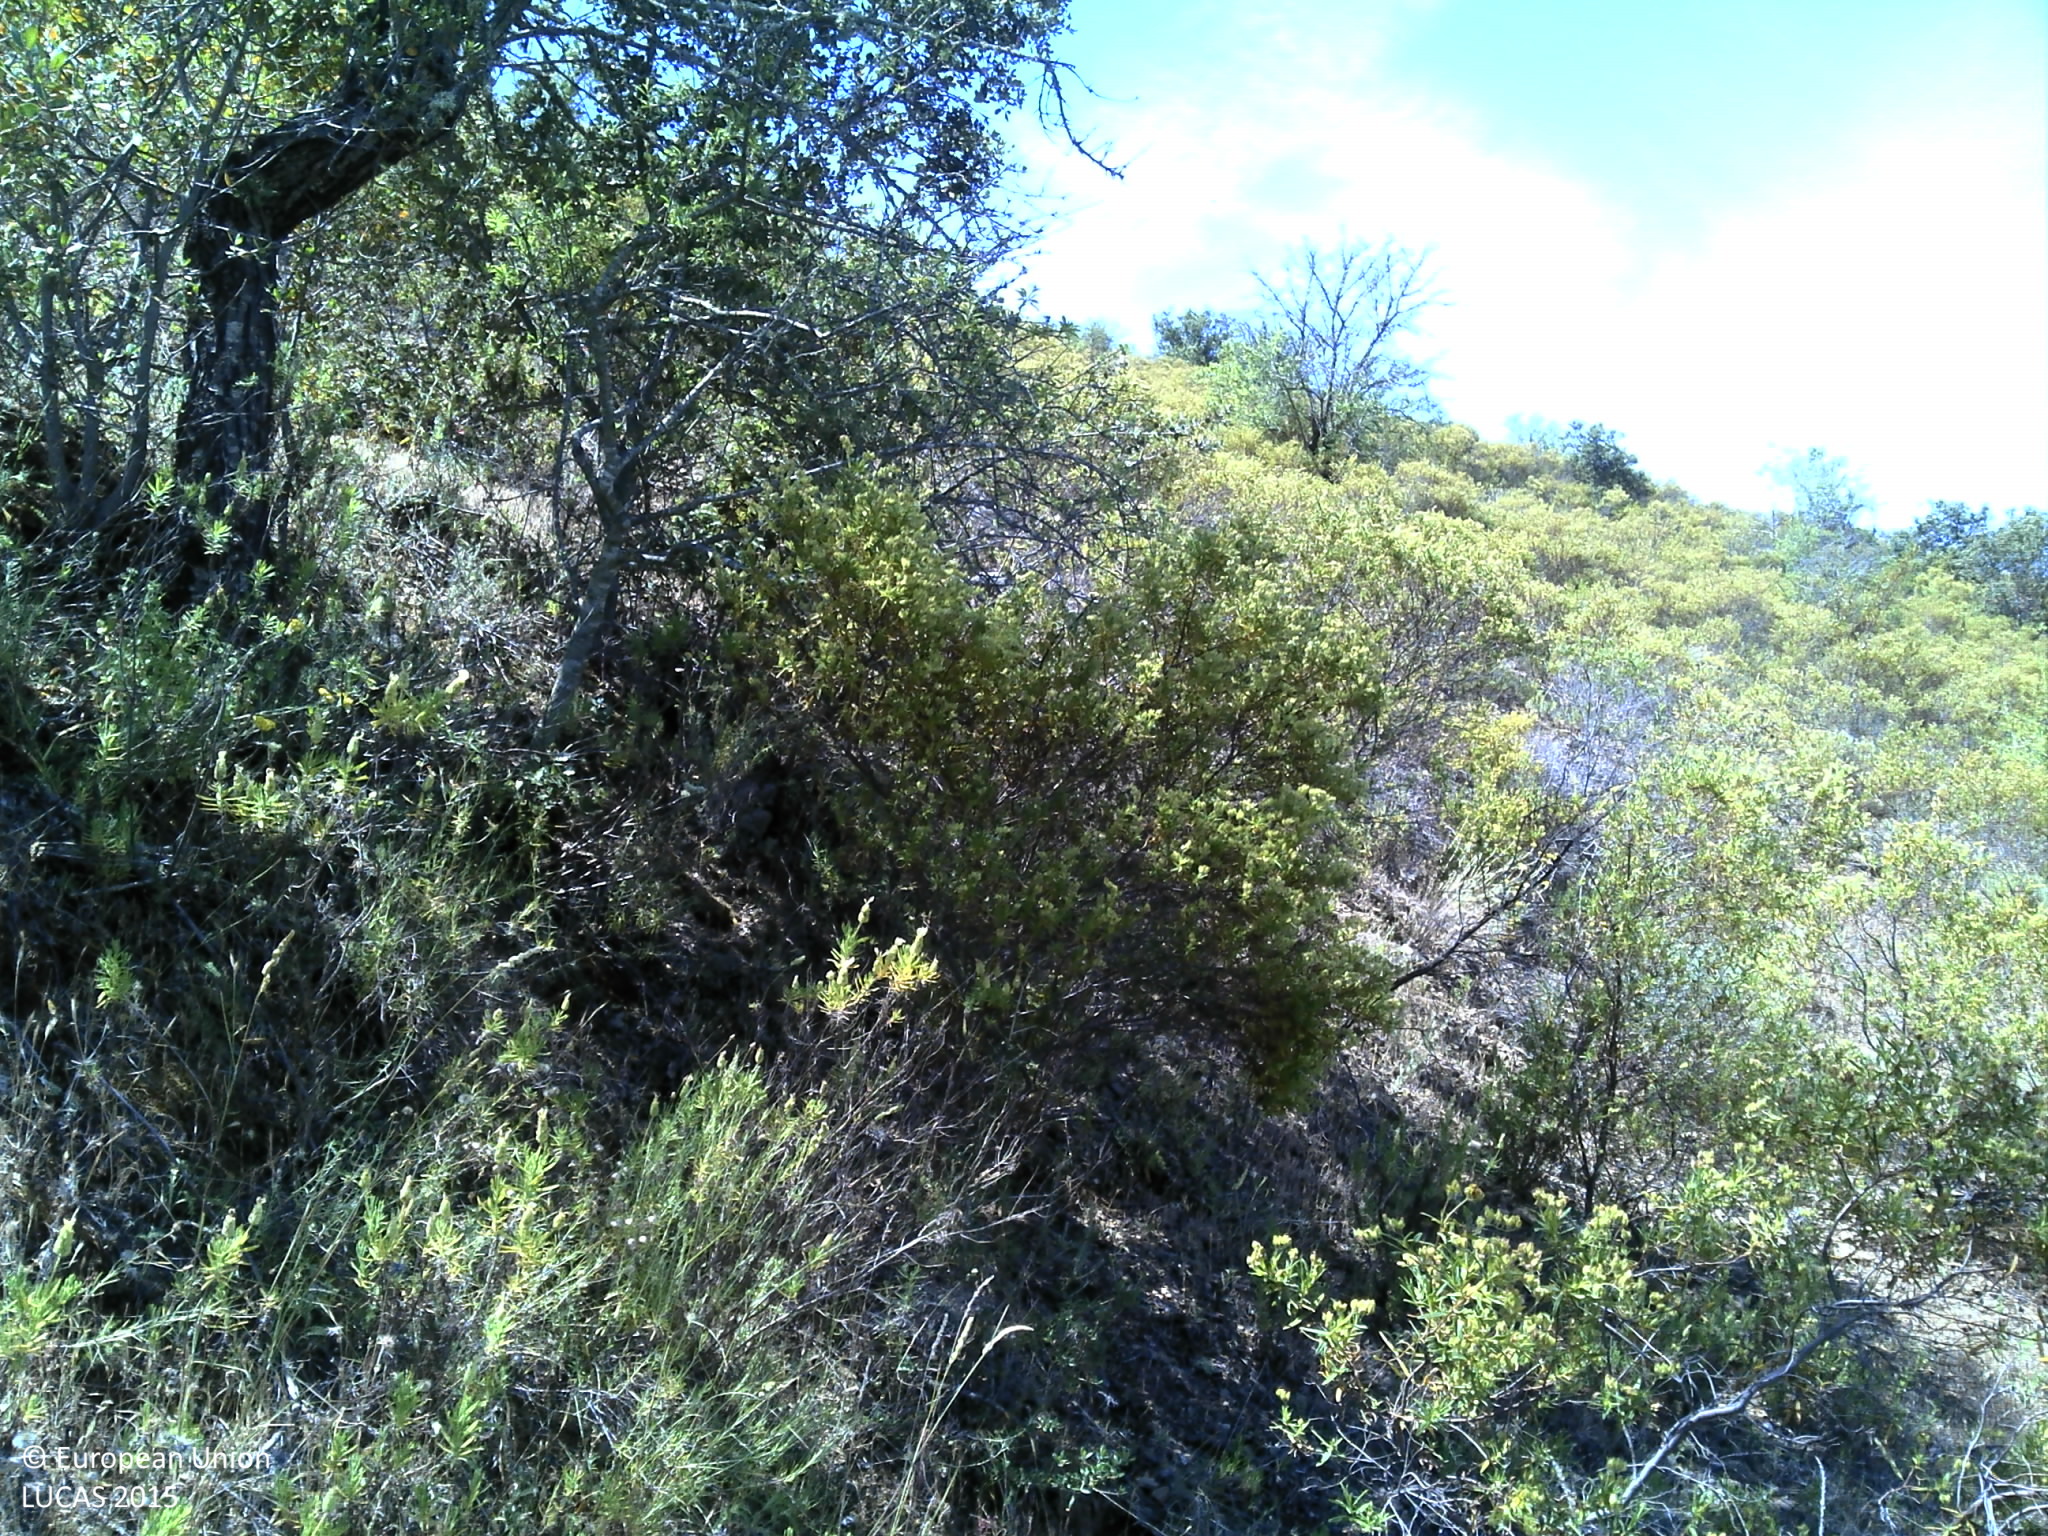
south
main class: Cropland
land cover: Nuts trees
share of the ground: 10 - 25 %
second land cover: Shrubland without tree cover
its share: 50 - 75 %
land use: Agriculture (excluding fallow land and kitchen gardens)
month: May
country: PT
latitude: 37.3910
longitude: -7.4801
